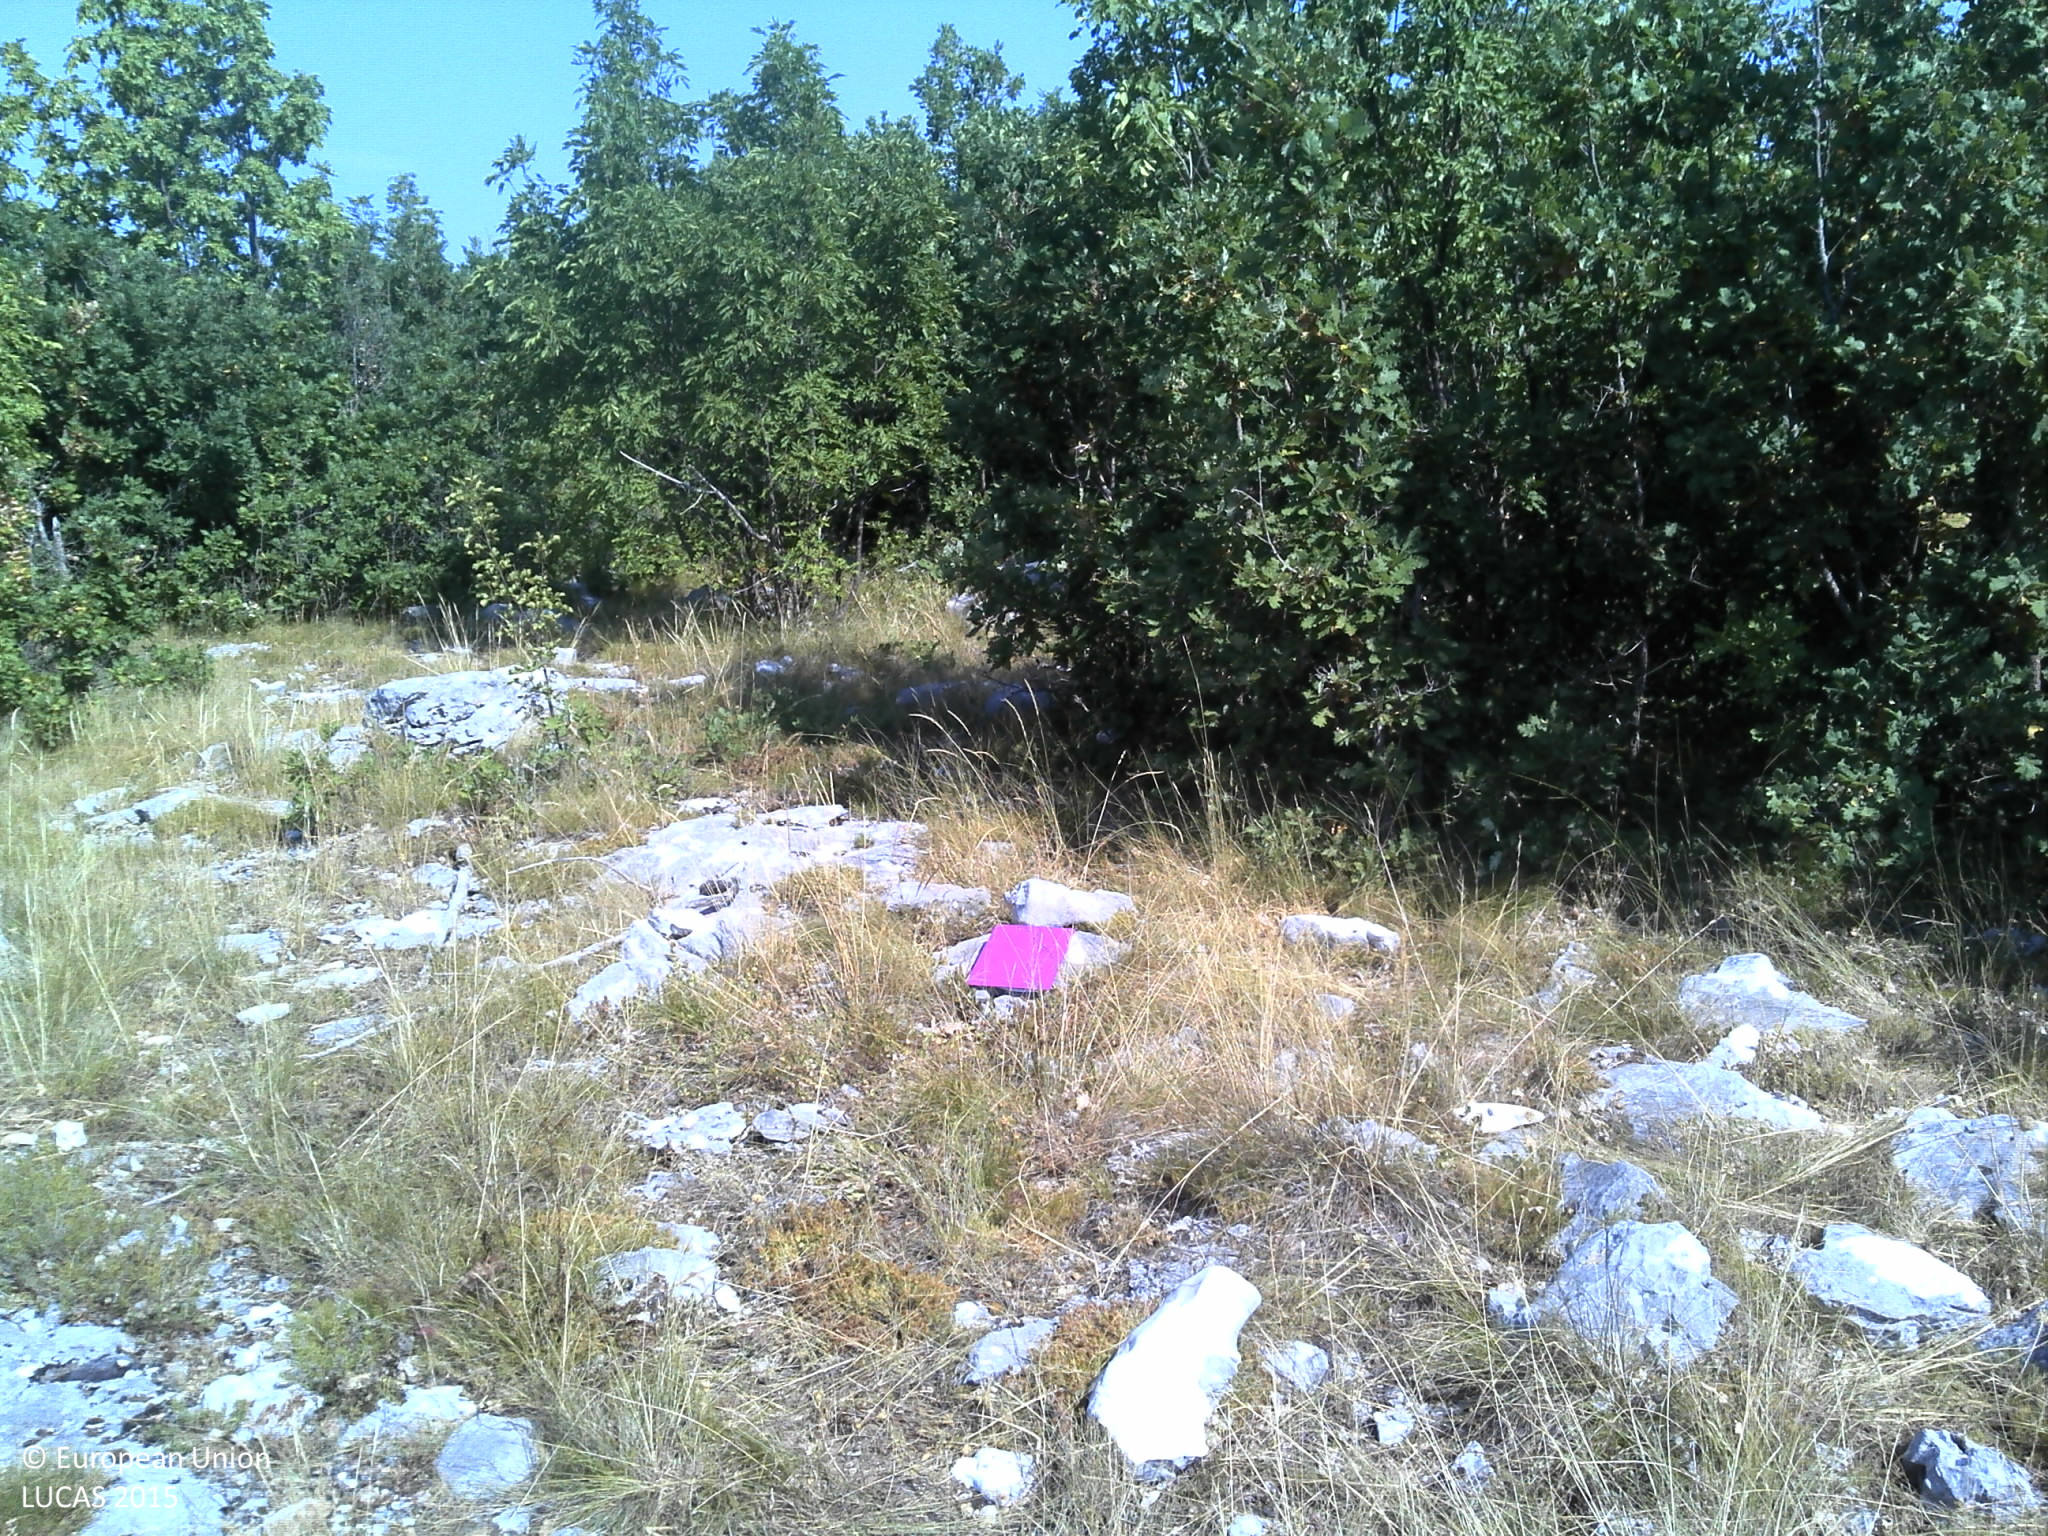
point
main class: Woodland
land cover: Broadleaved woodland
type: thermophilous deciduous forest
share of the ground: 50 - 75 %
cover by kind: broadleaved forest trees 55 %, consolidated bare surface 20 %, shrubs 15 %, herbaceous plants 10 %
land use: Semi-natural and natural areas not in use
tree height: > 5 m
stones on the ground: 10 - 25 %
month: July
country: HR
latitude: 43.5947
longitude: 16.9162
